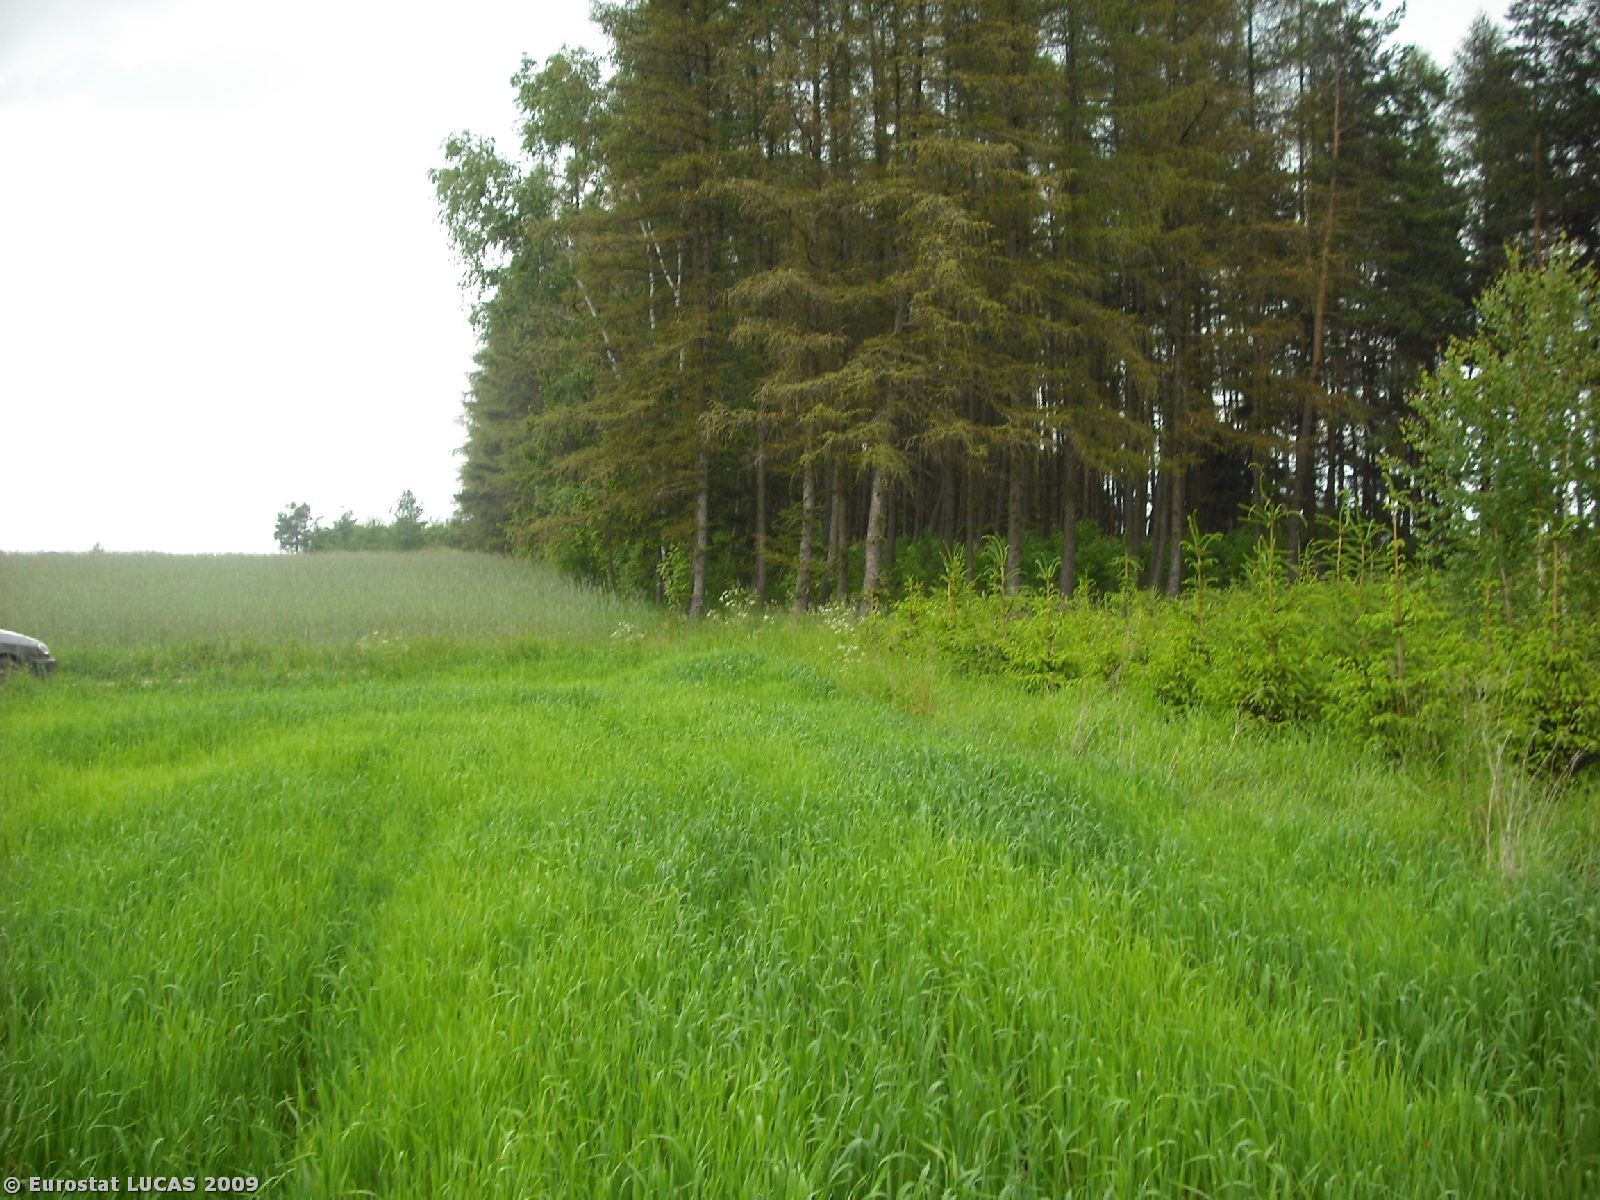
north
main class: Cropland
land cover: Oats
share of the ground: > 75 %
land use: Agriculture (excluding fallow land and kitchen gardens)
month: June
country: PL
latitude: 54.1732
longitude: 22.8311
